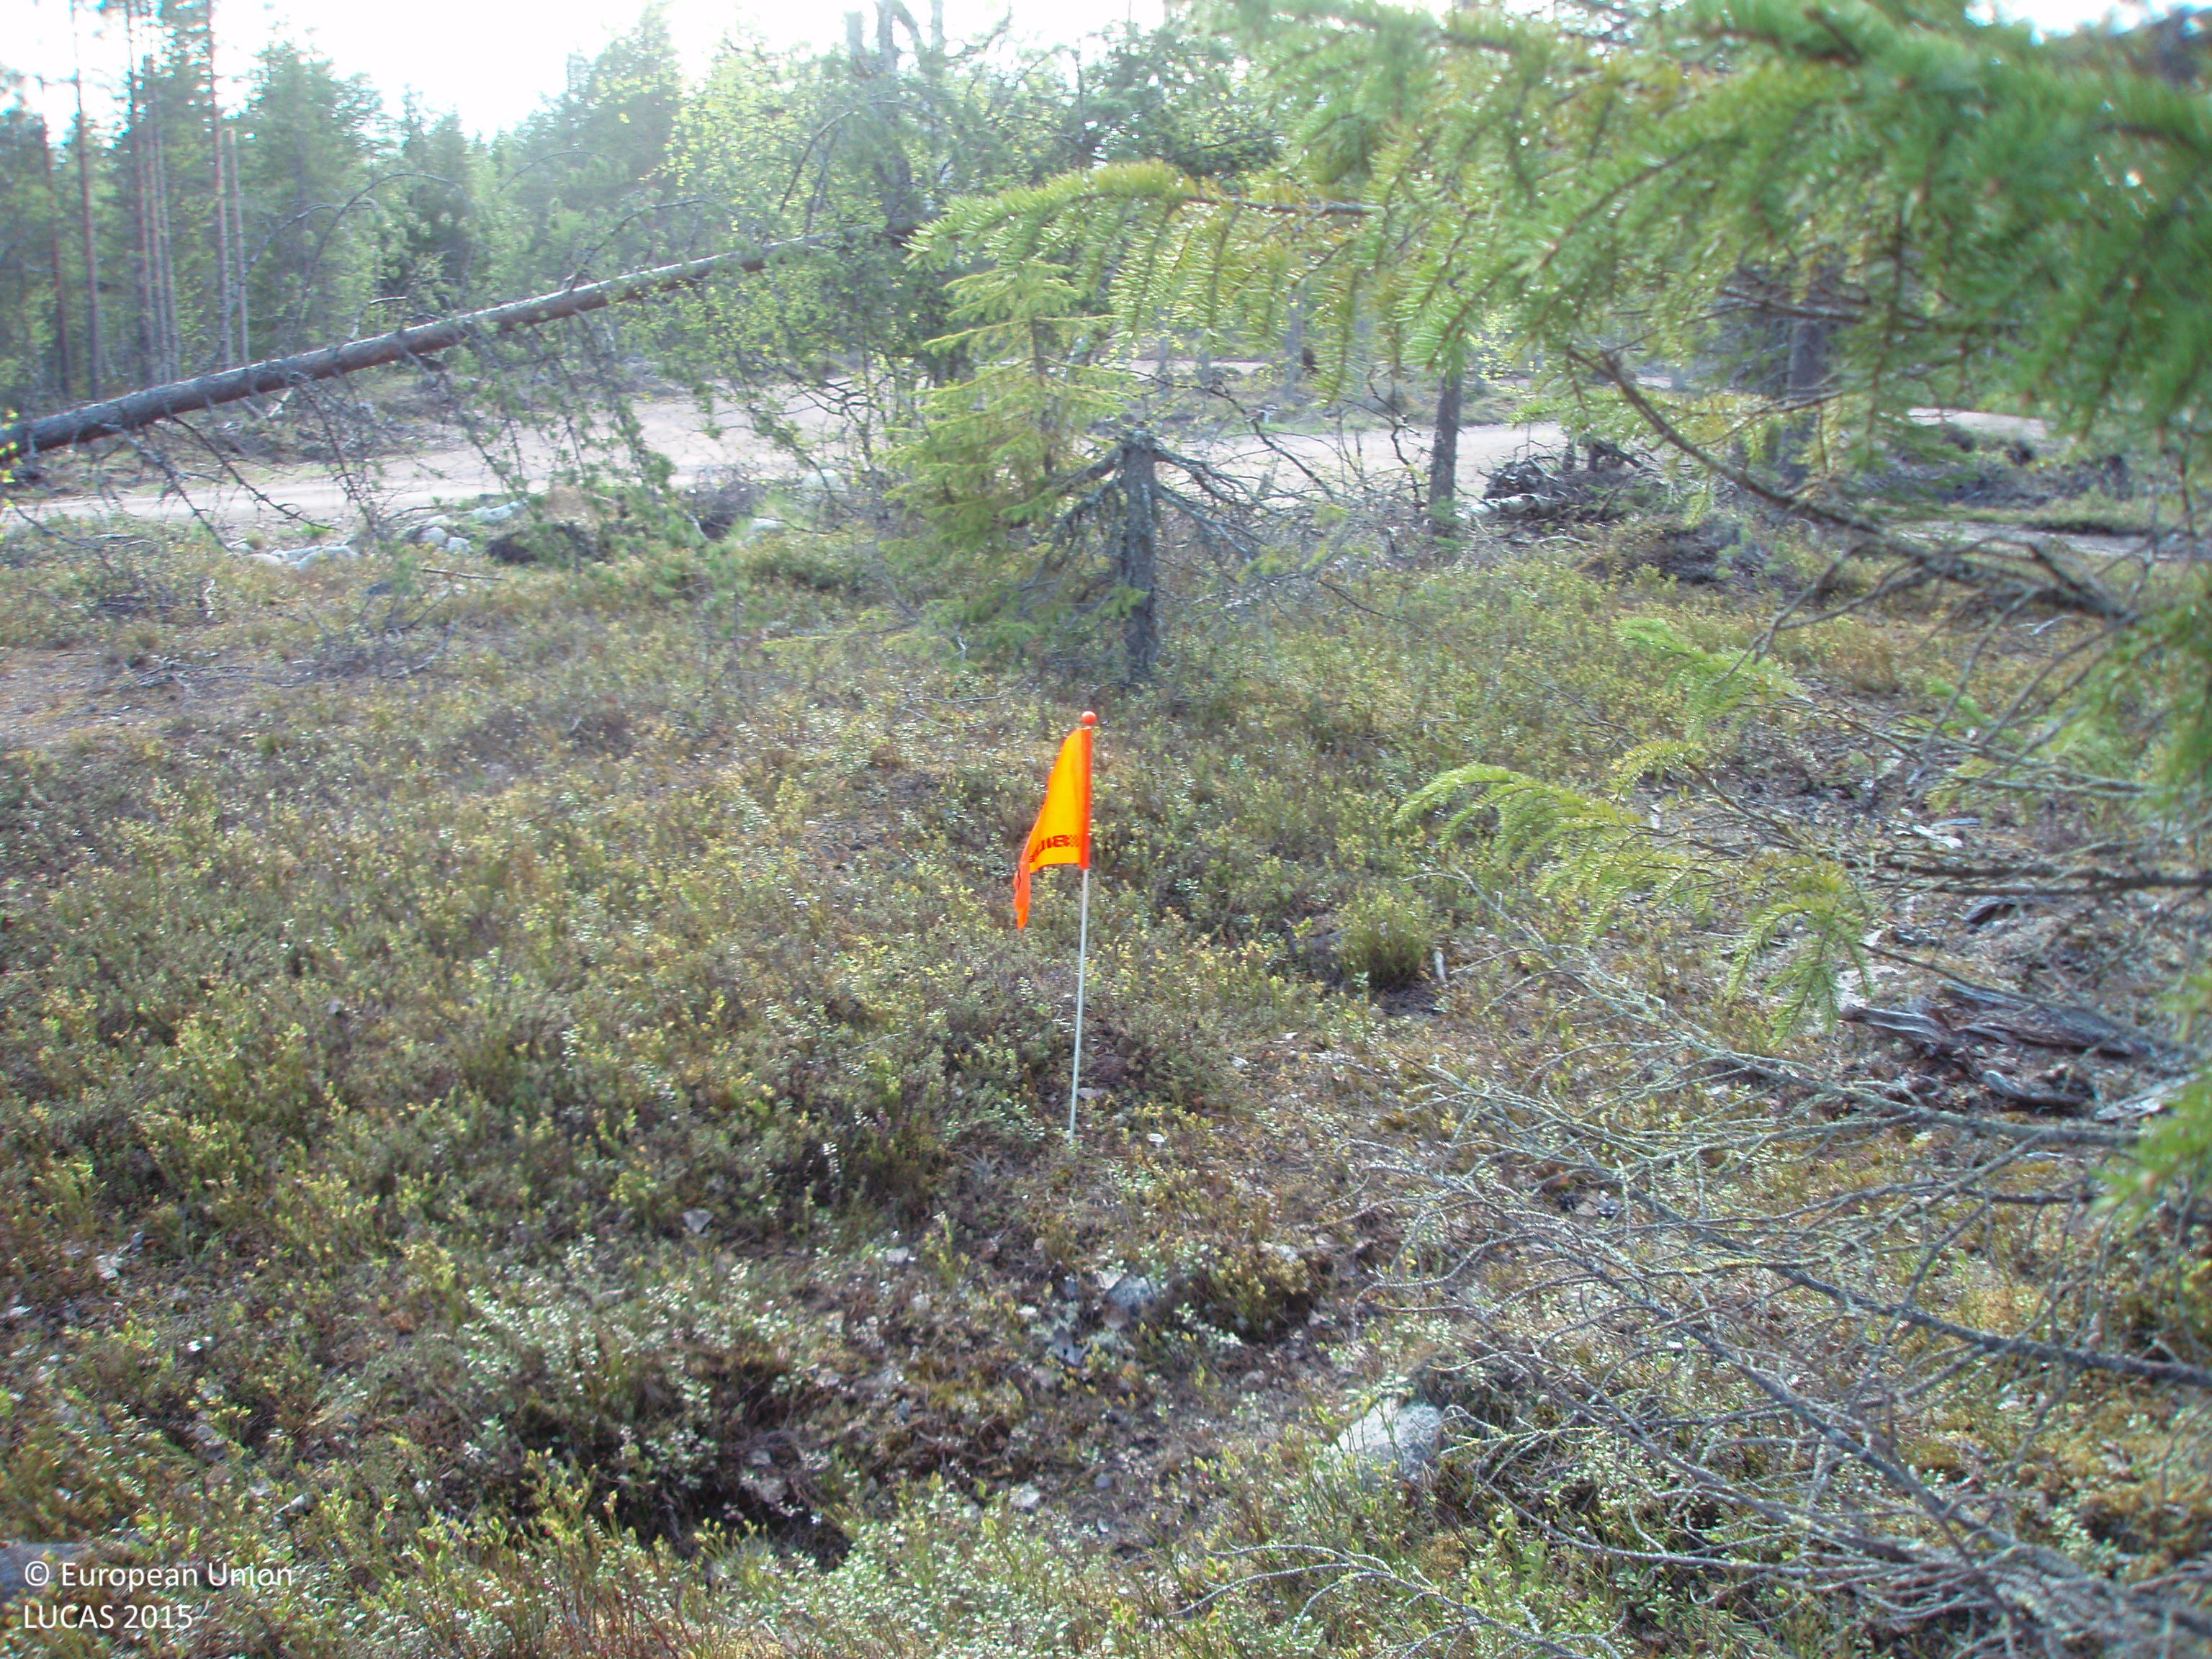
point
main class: Woodland
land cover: Pine dominated coniferous woodland
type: boreal forest
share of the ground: 50 - 75 %
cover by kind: coniferous forest trees 65 %, shrubs 20 %, broadleaved forest trees 5 %, lichens and mosses 5 %, unconsolidated bare surface 5 %
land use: Forestry
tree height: > 5 m
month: June
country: FI
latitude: 66.6787
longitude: 26.5419
